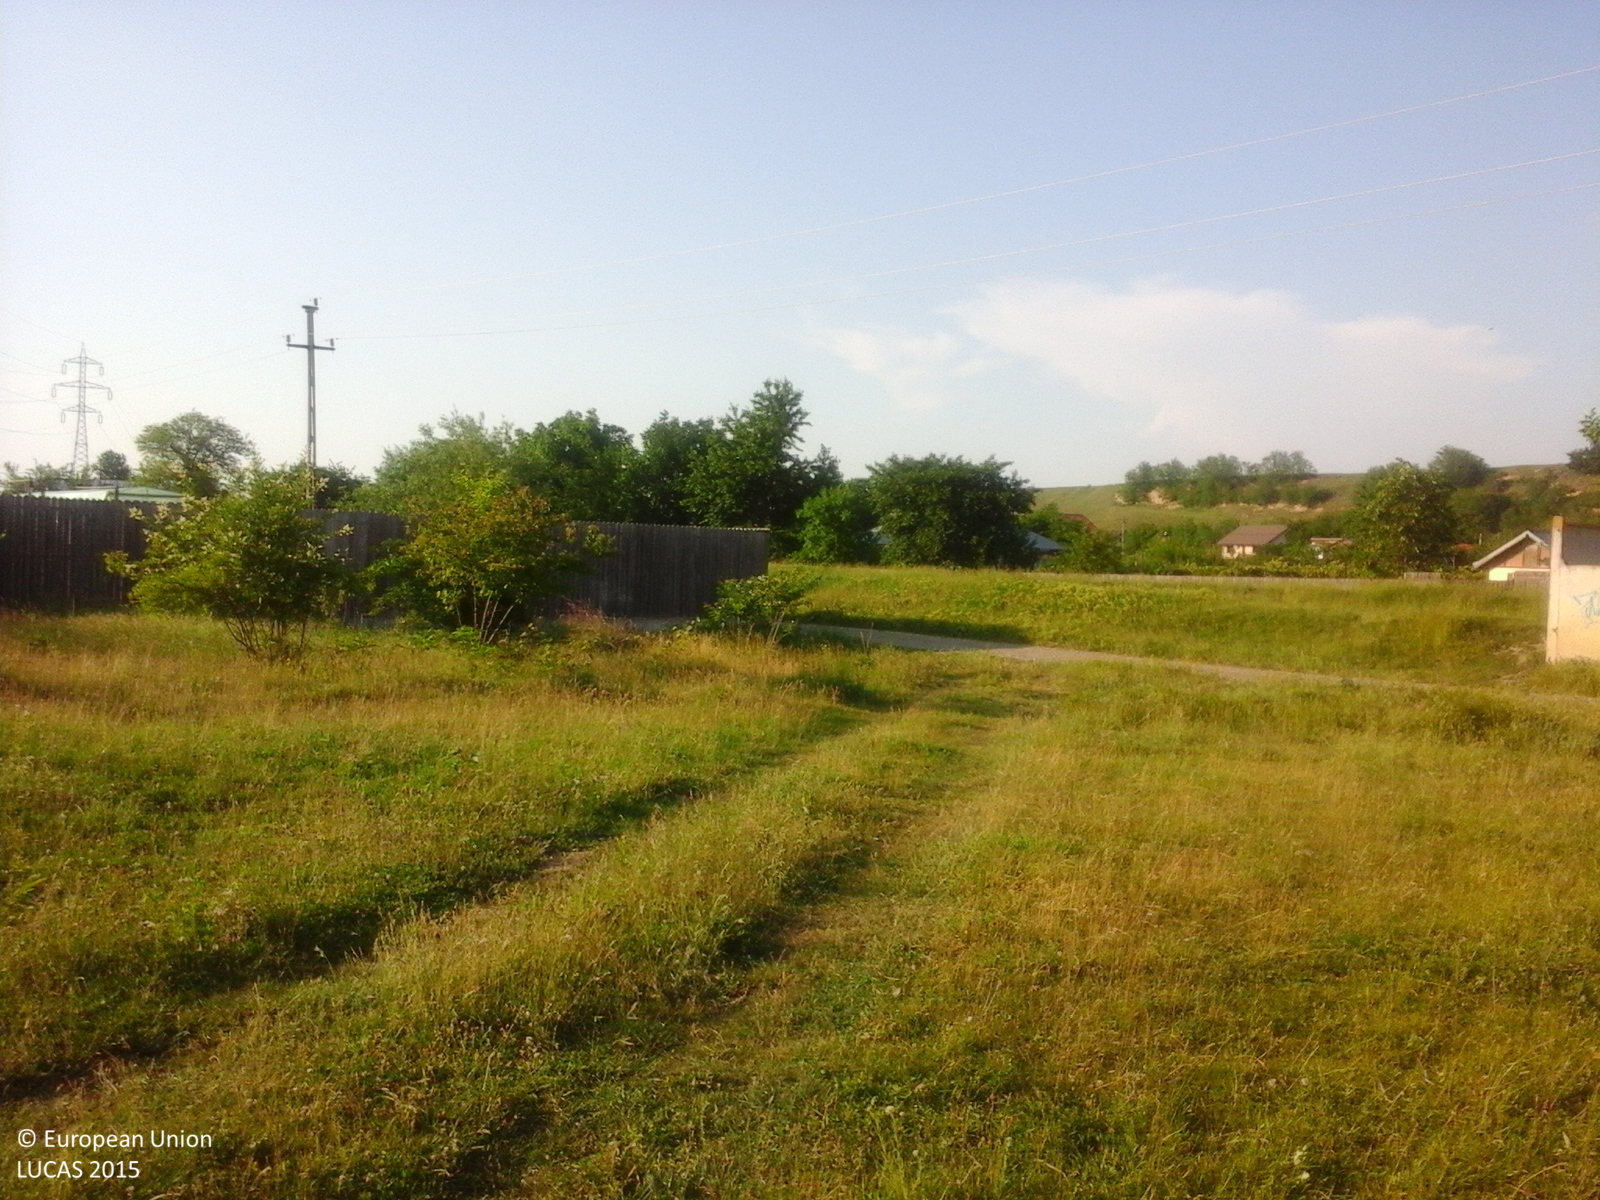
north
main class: Grassland
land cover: Grassland without tree/shrub cover
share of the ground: > 75 %
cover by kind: herbaceous plants 100 %
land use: Agriculture (excluding fallow land and kitchen gardens)
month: June
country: RO
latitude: 46.5865
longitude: 26.9437
